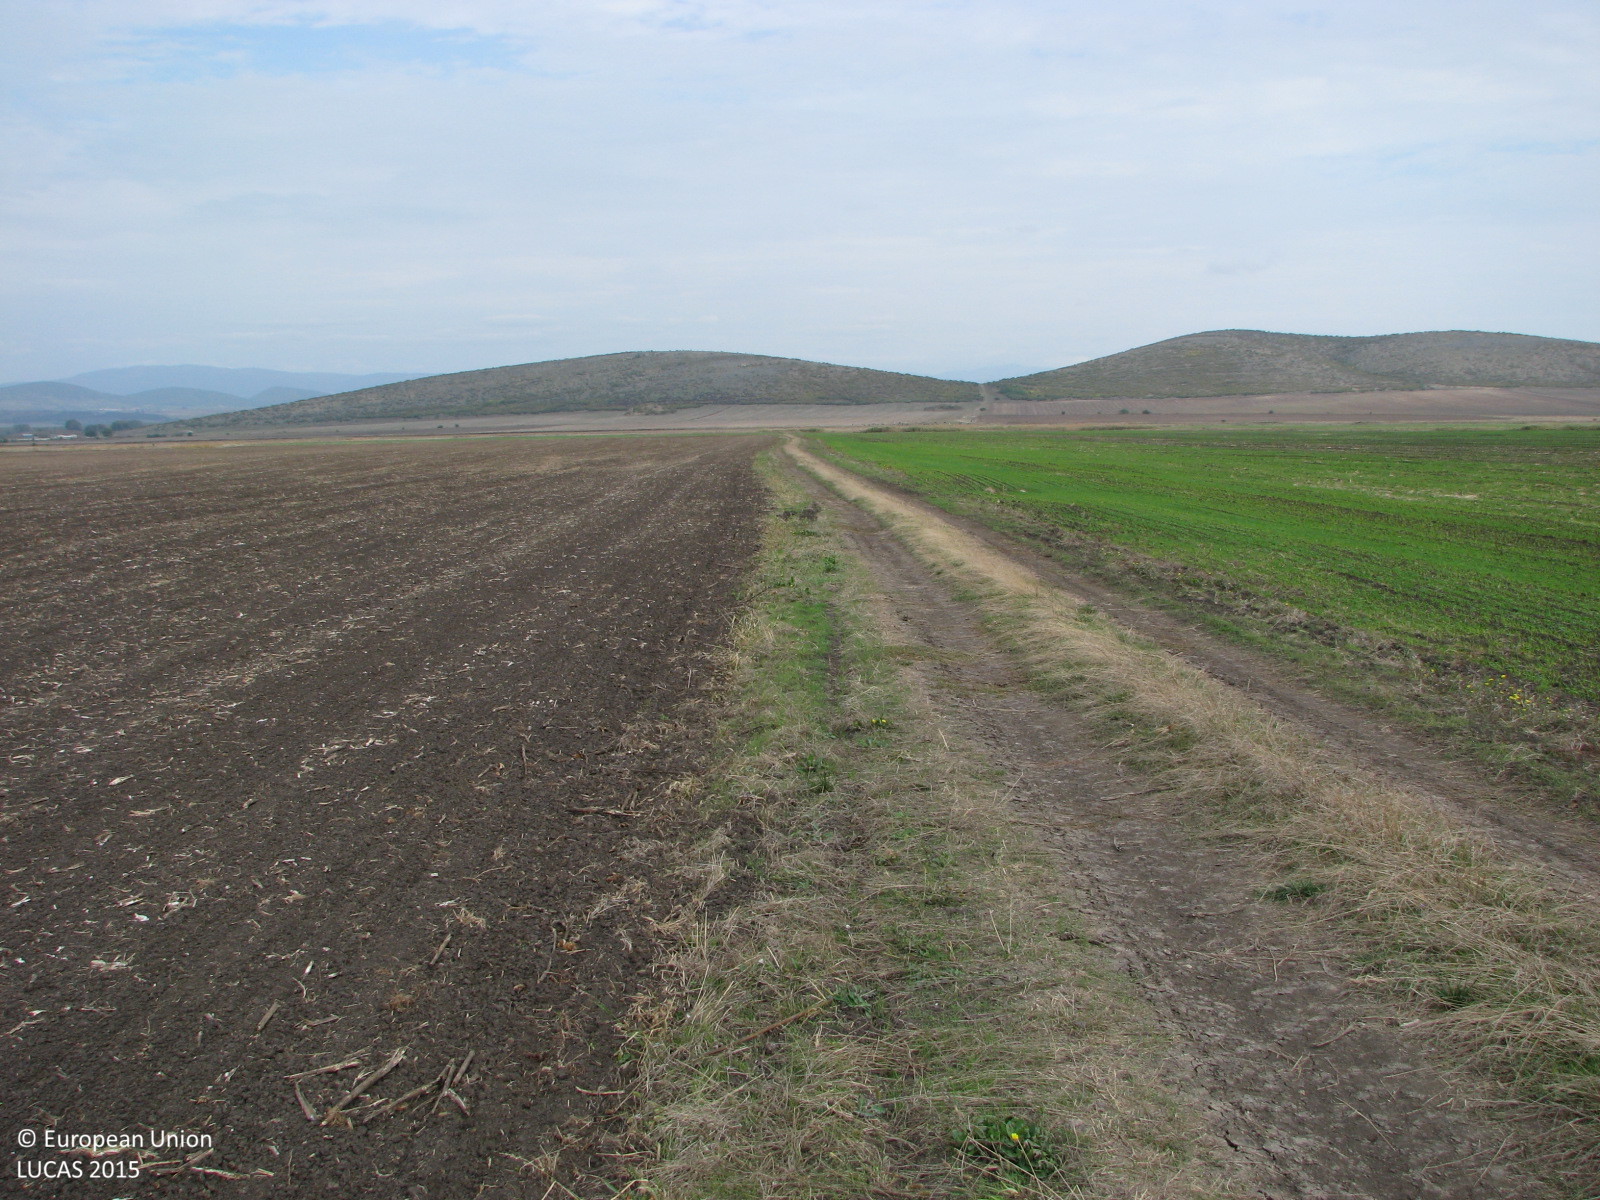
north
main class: Cropland
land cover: Sunflower
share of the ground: < 10 %
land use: Agriculture (excluding fallow land and kitchen gardens)
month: October
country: BG
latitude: 42.4866
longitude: 26.1553
